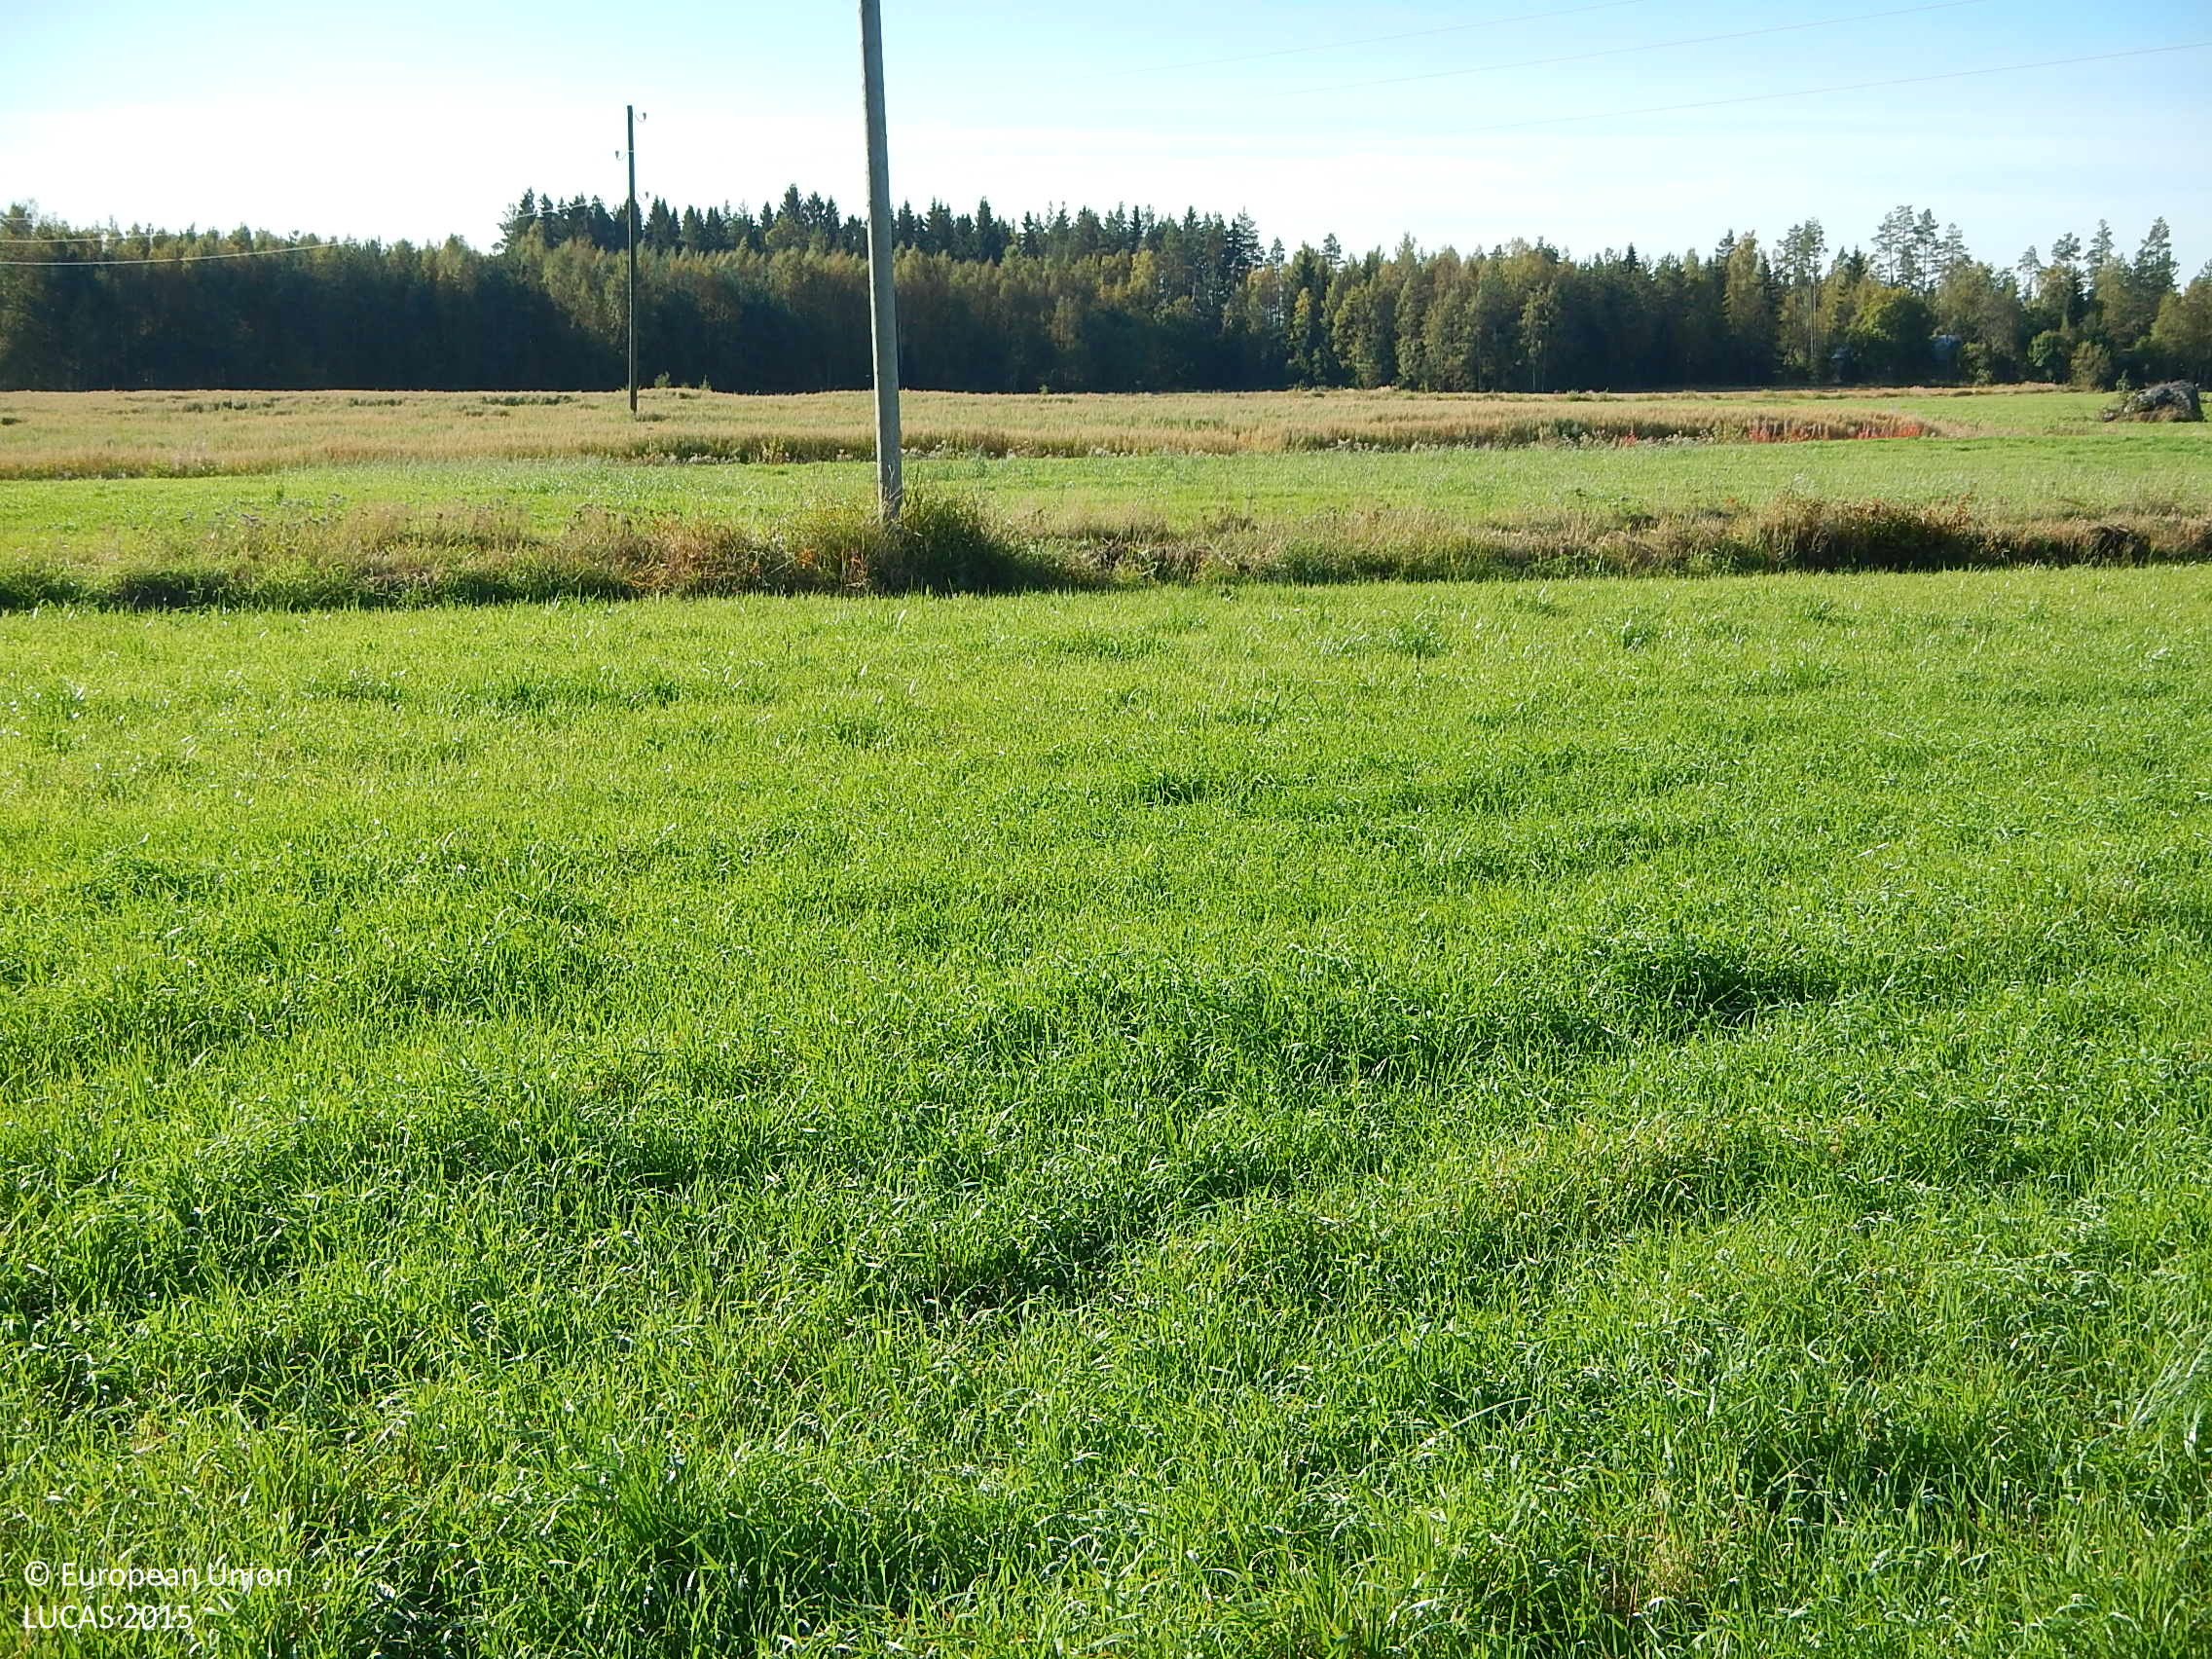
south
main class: Cropland
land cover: Temporary grasslands
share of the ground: > 75 %
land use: Agriculture (excluding fallow land and kitchen gardens)
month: September
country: FI
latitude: 61.8475
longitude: 21.6582
